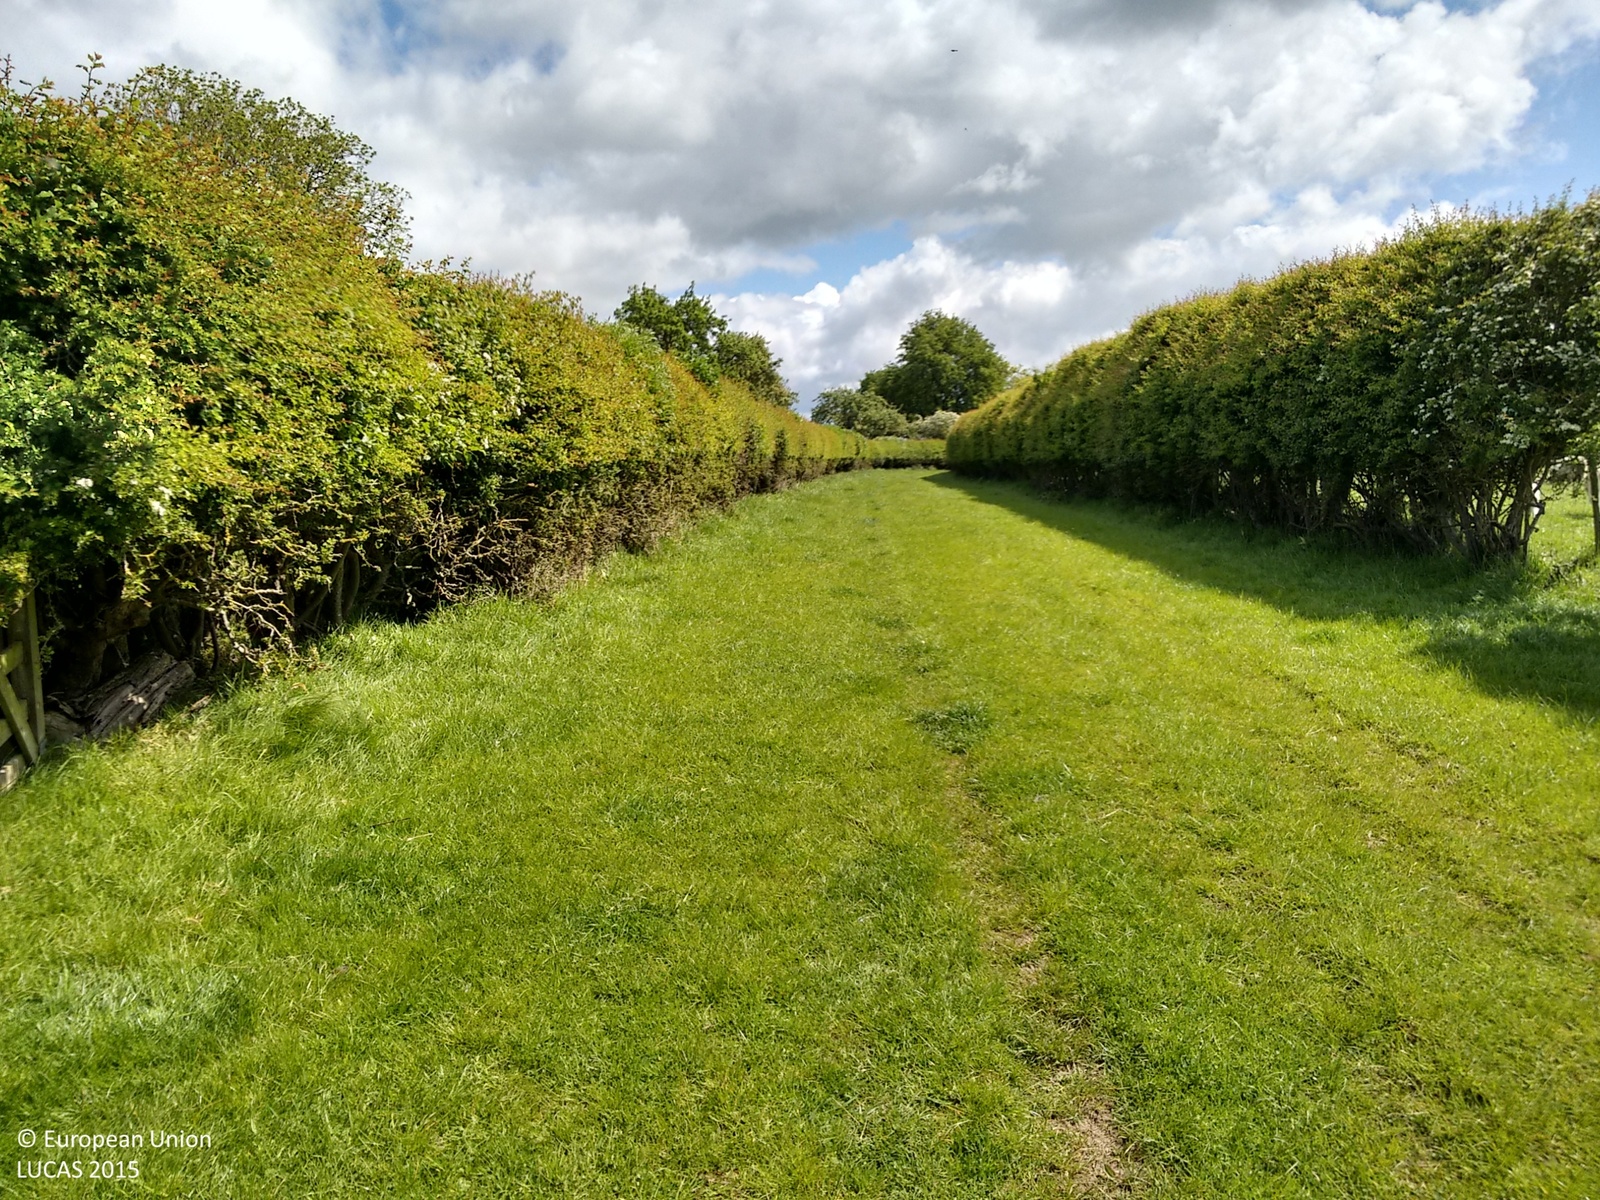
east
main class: Grassland
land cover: Grassland without tree/shrub cover
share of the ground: > 75 %
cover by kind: herbaceous plants 100 %
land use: Agriculture (excluding fallow land and kitchen gardens)
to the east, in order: Grassland without tree/shrub cover; Fences; Grassland with sparse tree/shrub cover; Fences; Managed hedges; Grassland without tree/shrub cover; Managed hedges; Grass margins; Paved roads, cycling and walking lanes; Grass margins; Managed hedges; Grassland without tree/shrub cover
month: May
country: GB
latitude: 54.0037
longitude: -1.2290
